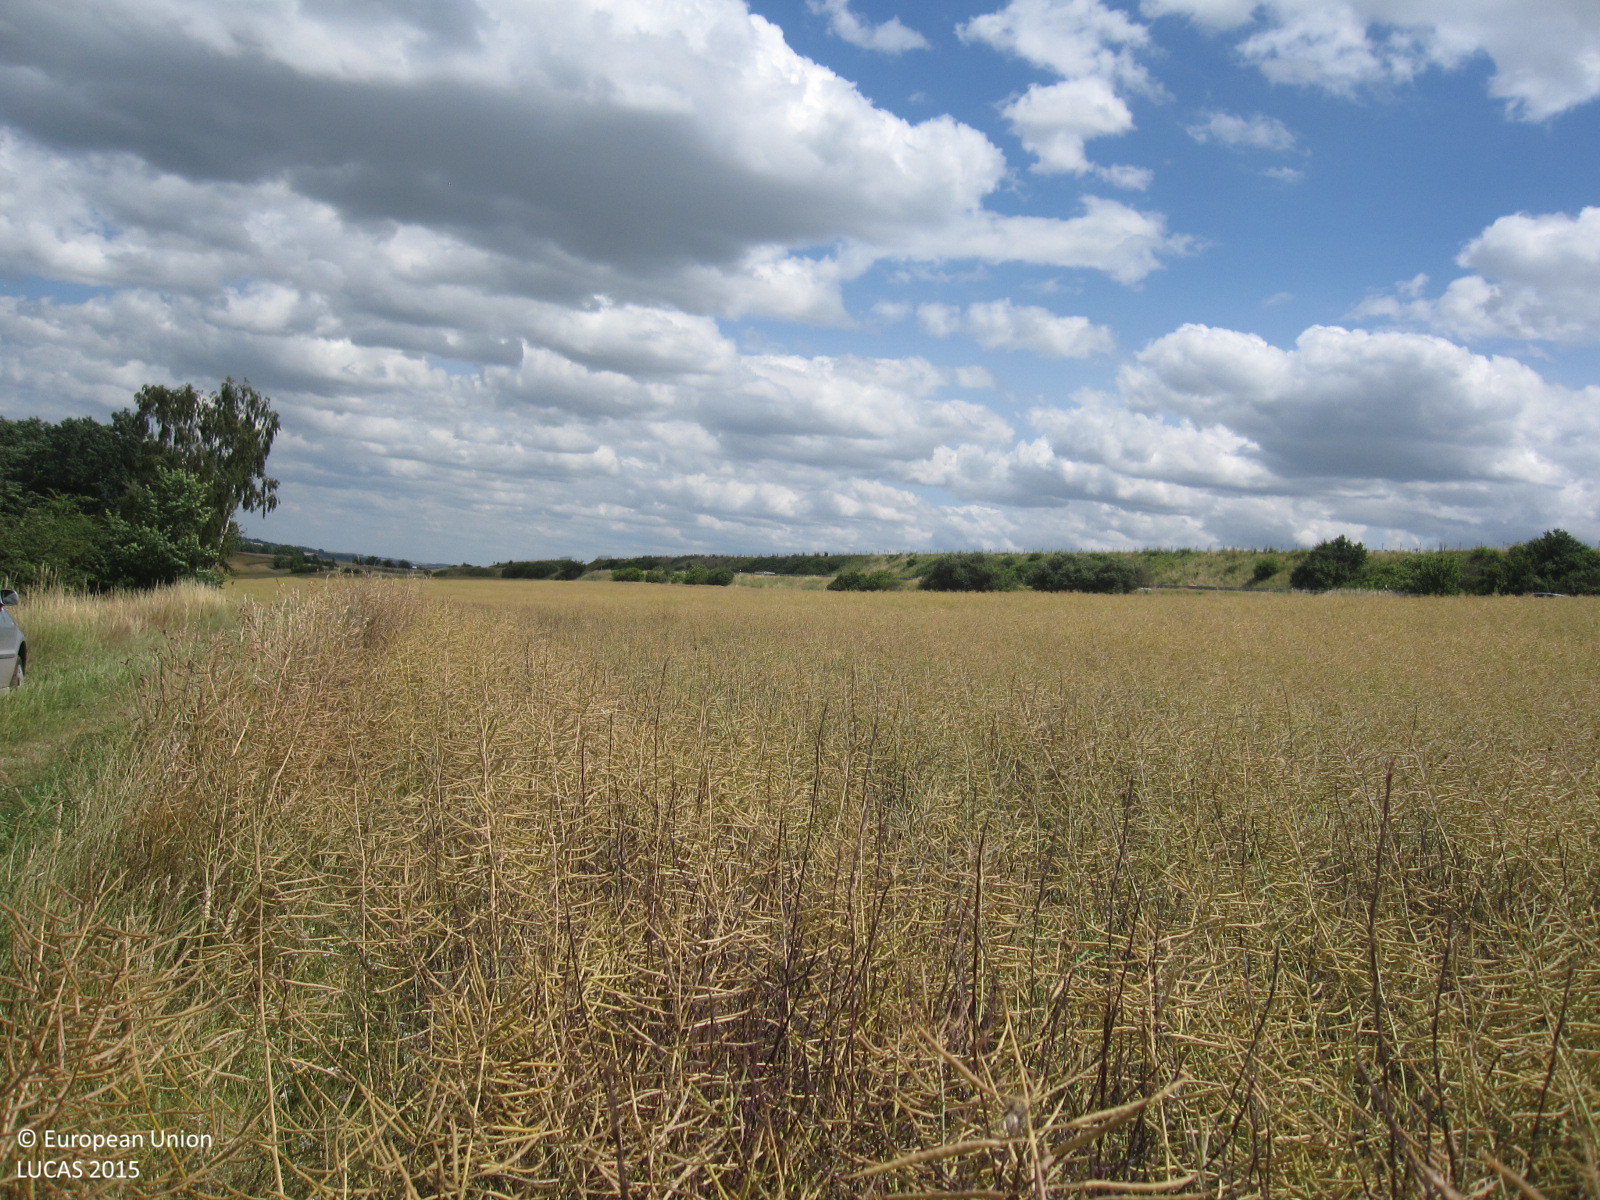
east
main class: Cropland
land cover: Rape and turnip rape
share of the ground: > 75 %
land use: Agriculture (excluding fallow land and kitchen gardens)
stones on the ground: < 10 %
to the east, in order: Rape and turnip rape; Grassland without tree/shrub cover; Broadleaved woodland
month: July
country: DE
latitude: 50.9040
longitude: 12.0047
